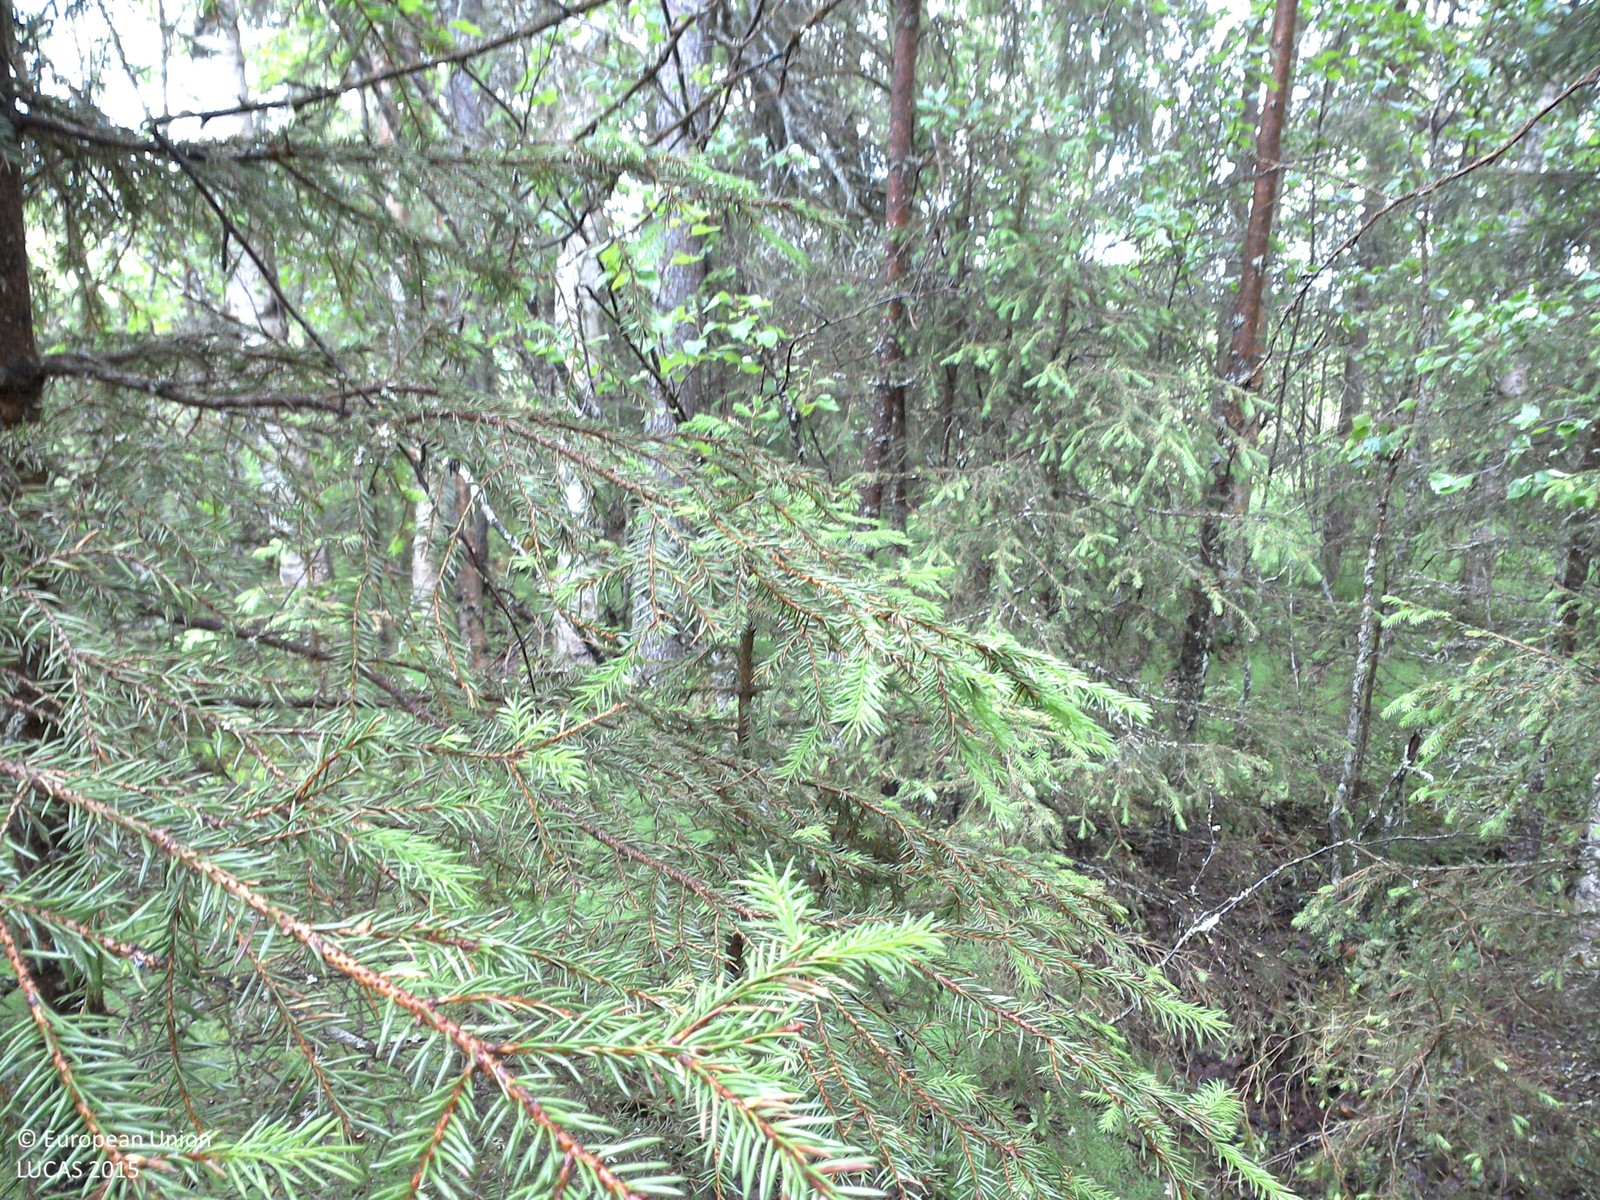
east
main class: Woodland
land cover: Spruce dominated mixed woodland
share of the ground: 50 - 75 %
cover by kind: coniferous forest trees 30 %, herbaceous plants 30 %, broadleaved forest trees 25 %, shrubs 10 %, unconsolidated bare surface 5 %
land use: Forestry
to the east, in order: Spruce dominated mixed woodland; Ditches and canals; Spruce dominated mixed woodland; Broadleaved woodland; Ditches and canals; Spruce dominated mixed woodland; Broadleaved woodland; Pine dominated mixed woodland; Grass margins; Pine dominated mixed woodland
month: July
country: SE
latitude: 66.5689
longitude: 23.3906
